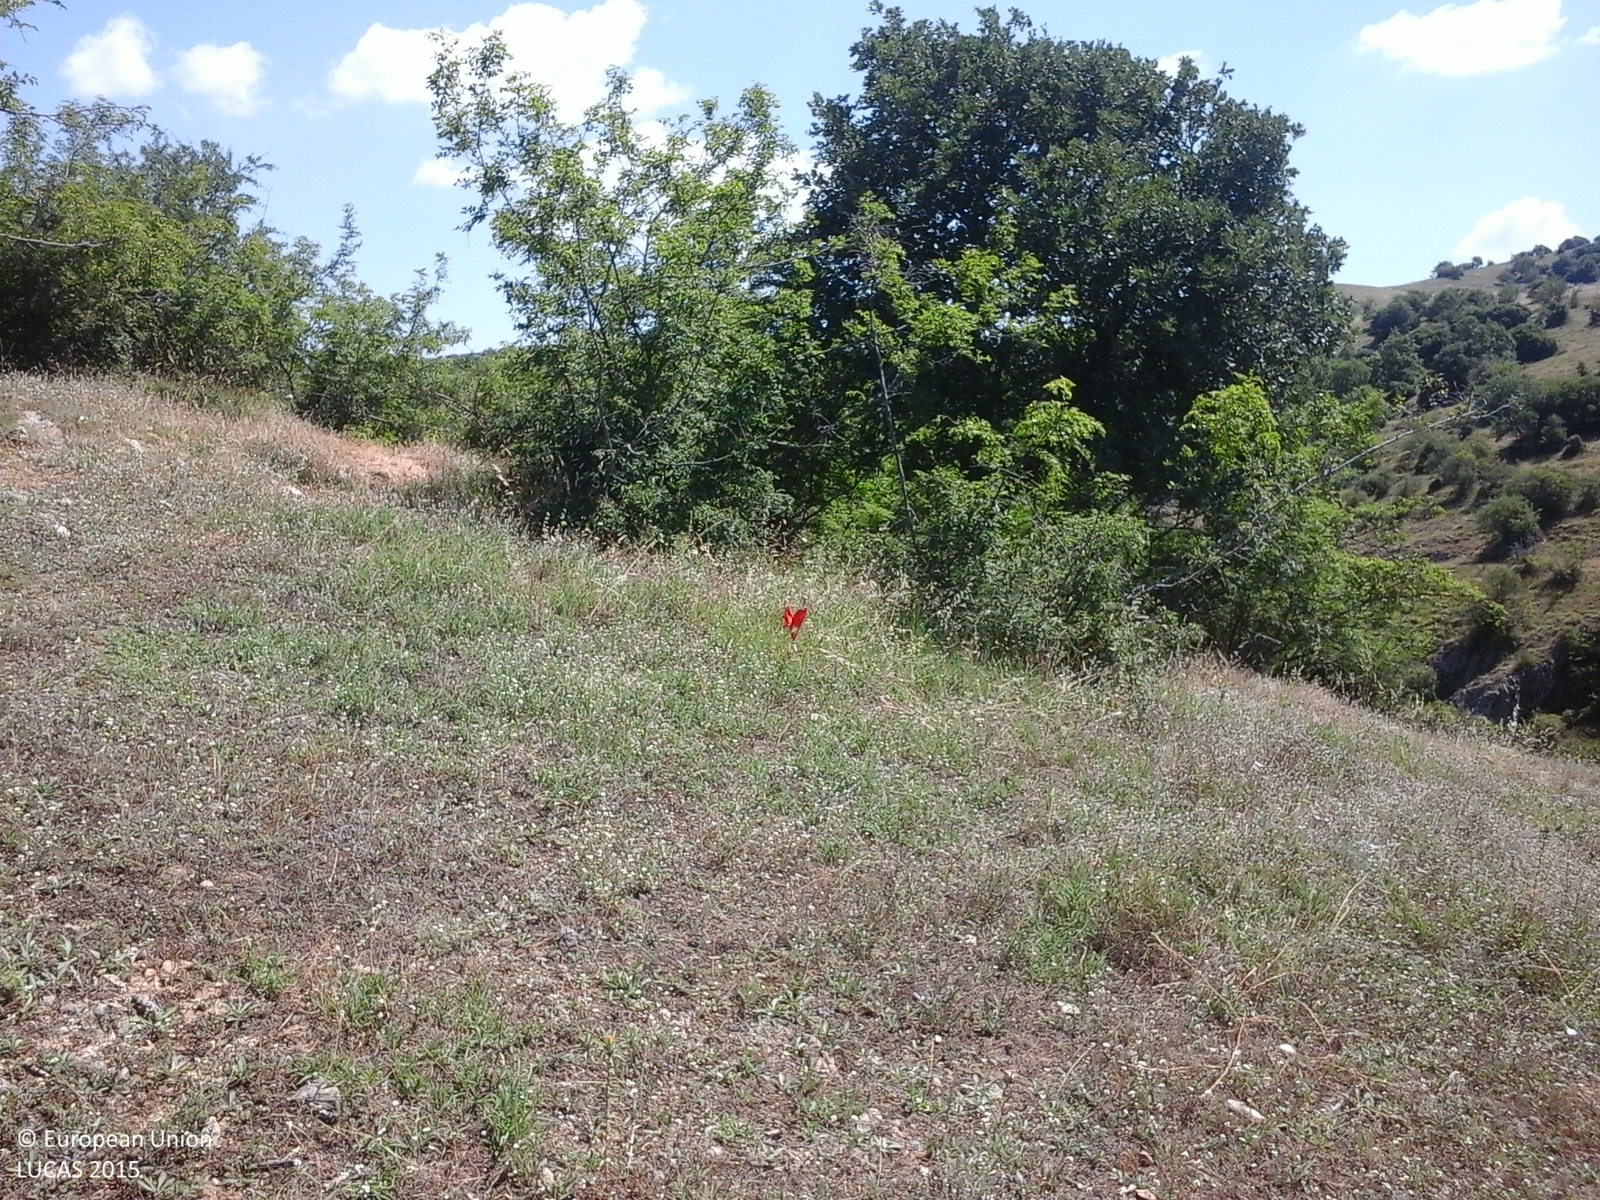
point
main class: Shrubland
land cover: Shrubland without tree cover
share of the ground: 50 - 75 %
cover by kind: shrubs 50 %, herbaceous plants 50 %
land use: Semi-natural and natural areas not in use
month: June
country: GR
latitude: 40.7771
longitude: 23.2234
